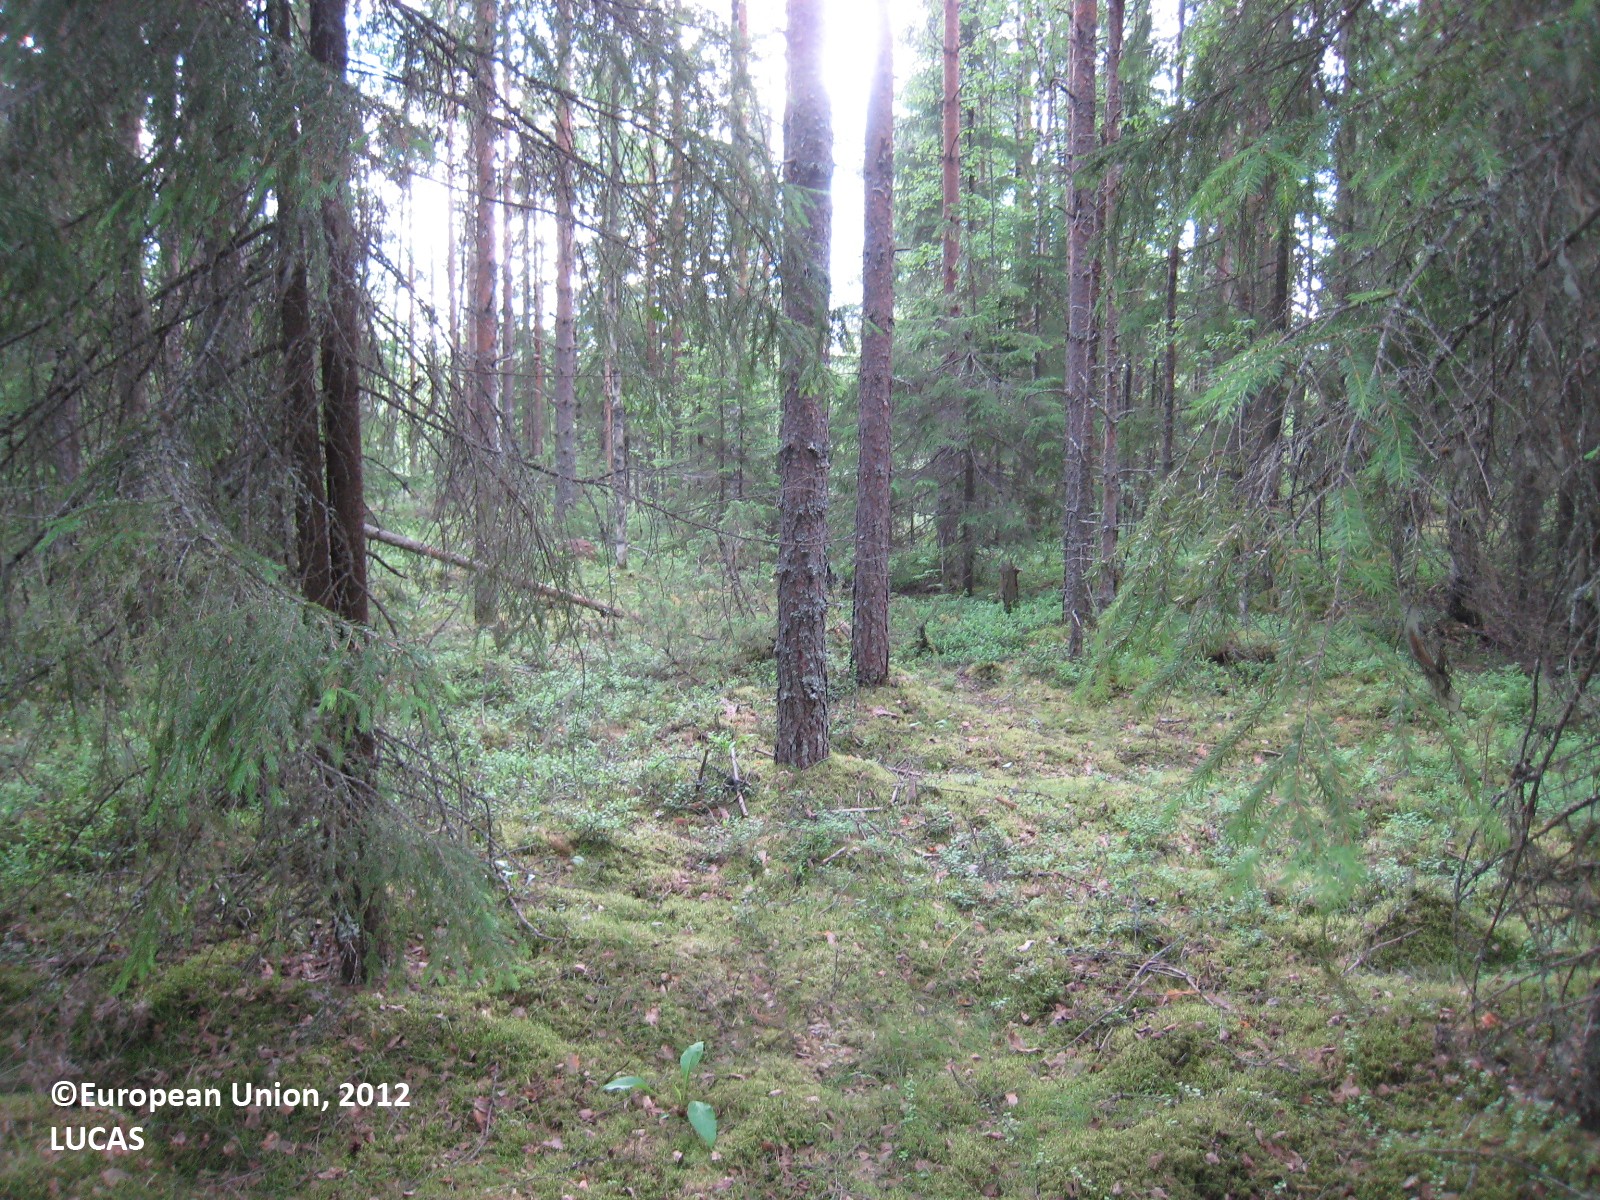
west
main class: Woodland
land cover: Other coniferous woodland
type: boreal forest
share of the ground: > 75 %
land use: Forestry
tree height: > 5 m
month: July
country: FI
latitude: 62.9616
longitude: 25.7089
